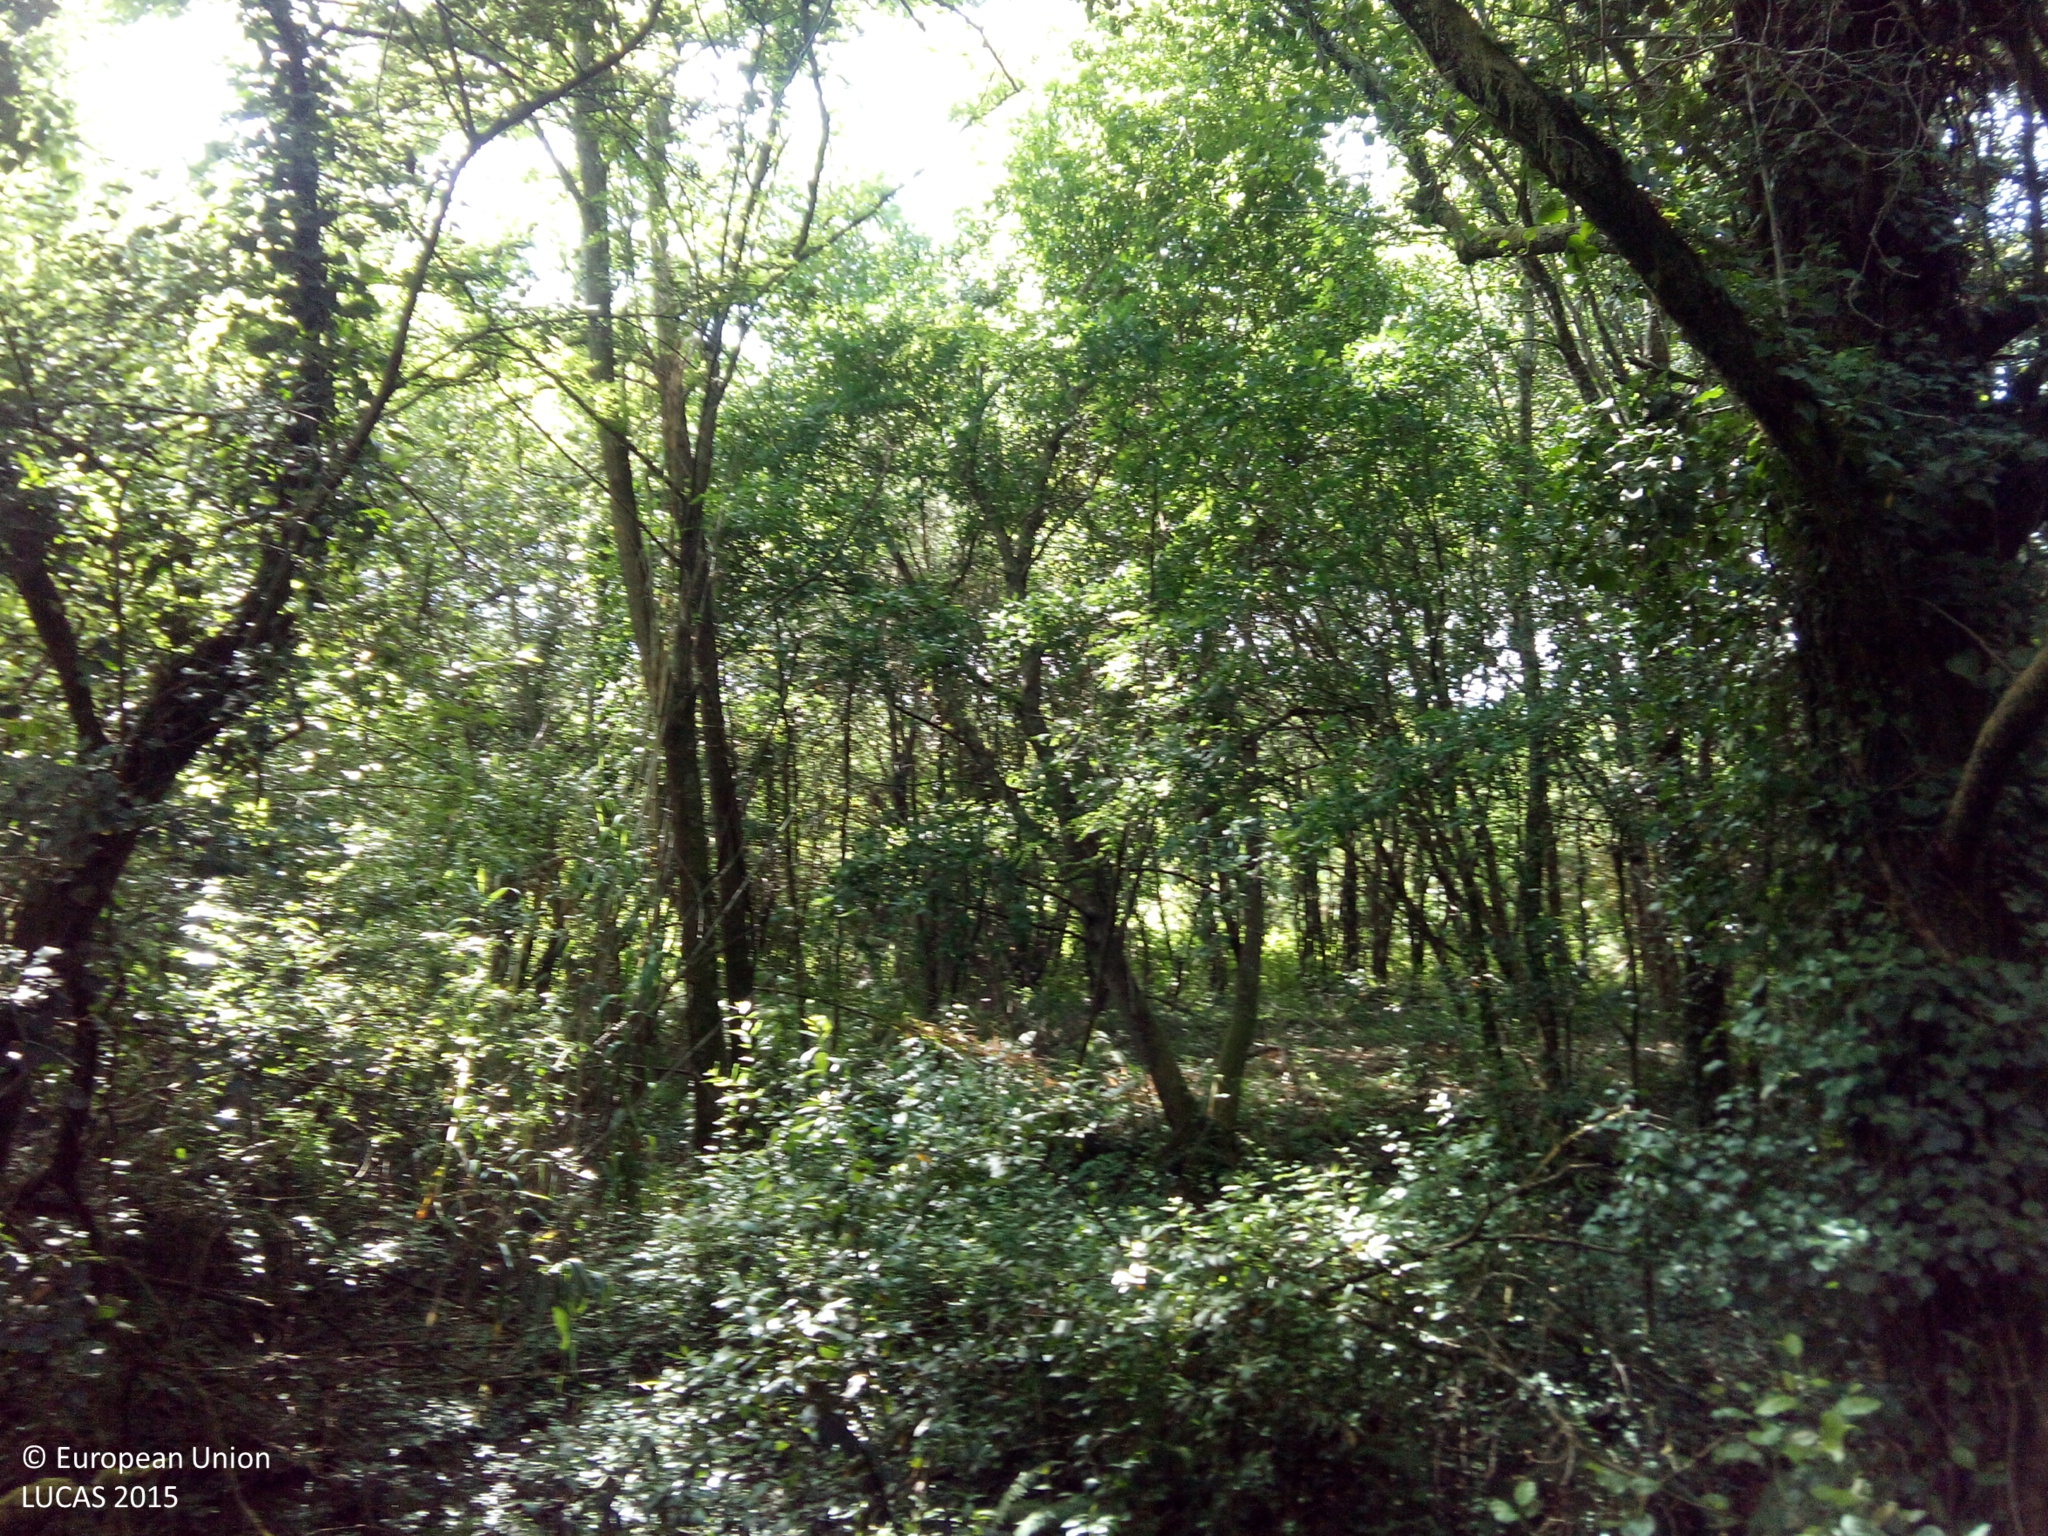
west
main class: Woodland
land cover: Broadleaved woodland
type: thermophilous deciduous forest
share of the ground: > 75 %
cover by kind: broadleaved forest trees 100 %
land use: Forestry
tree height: > 5 m
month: June
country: ES
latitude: 42.0996
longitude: -8.3836
